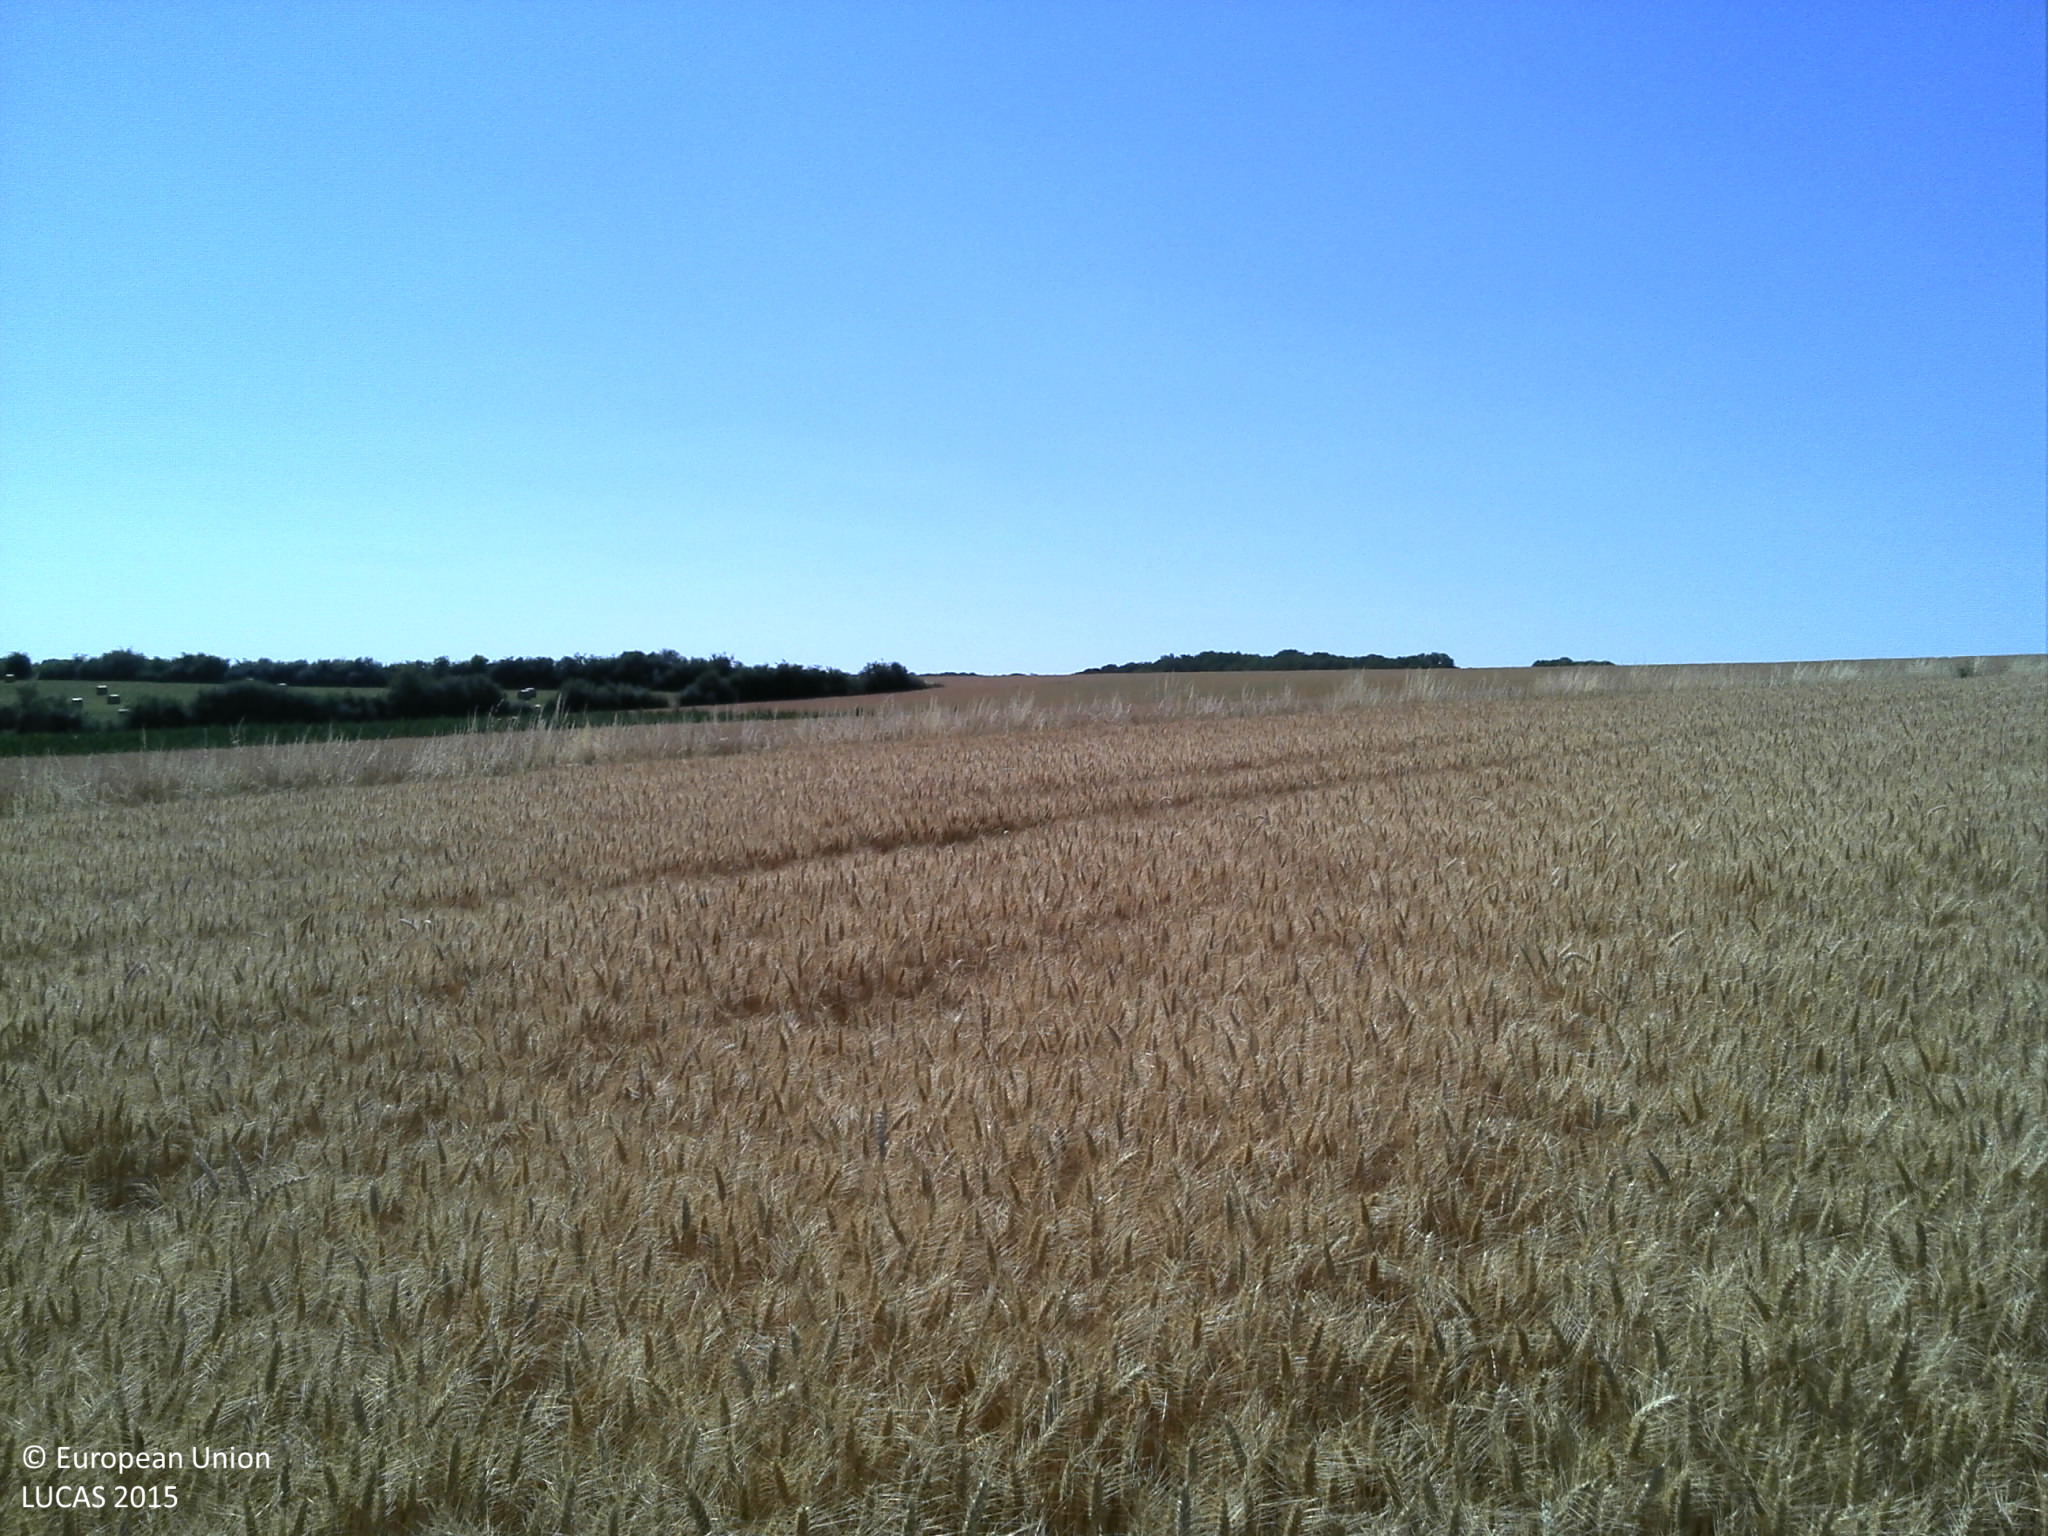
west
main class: Cropland
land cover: Common wheat
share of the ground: > 75 %
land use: Agriculture (excluding fallow land and kitchen gardens)
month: July
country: FR
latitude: 49.5232
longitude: 4.7612
